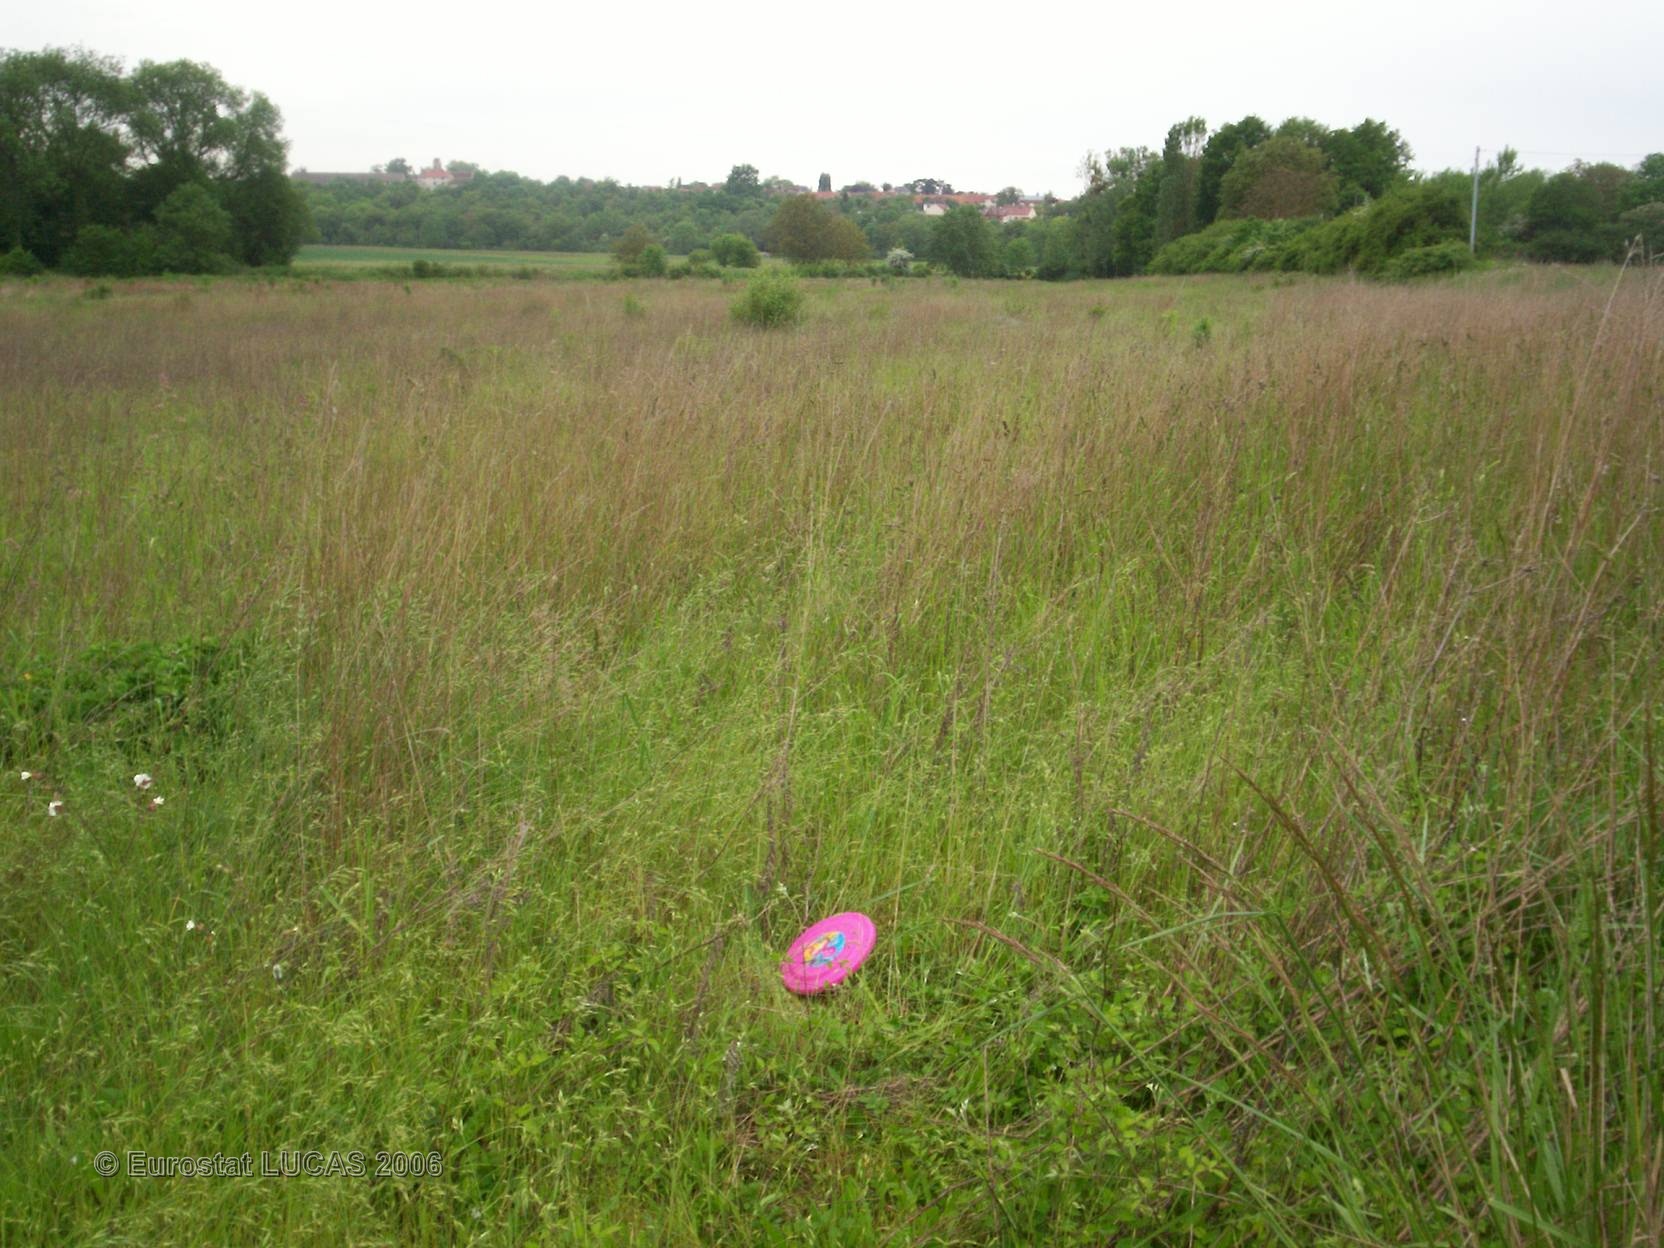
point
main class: Grassland
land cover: Grassland without tree/shrub cover
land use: Fallow land
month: May
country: FR
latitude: 48.6516
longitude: 2.7280
